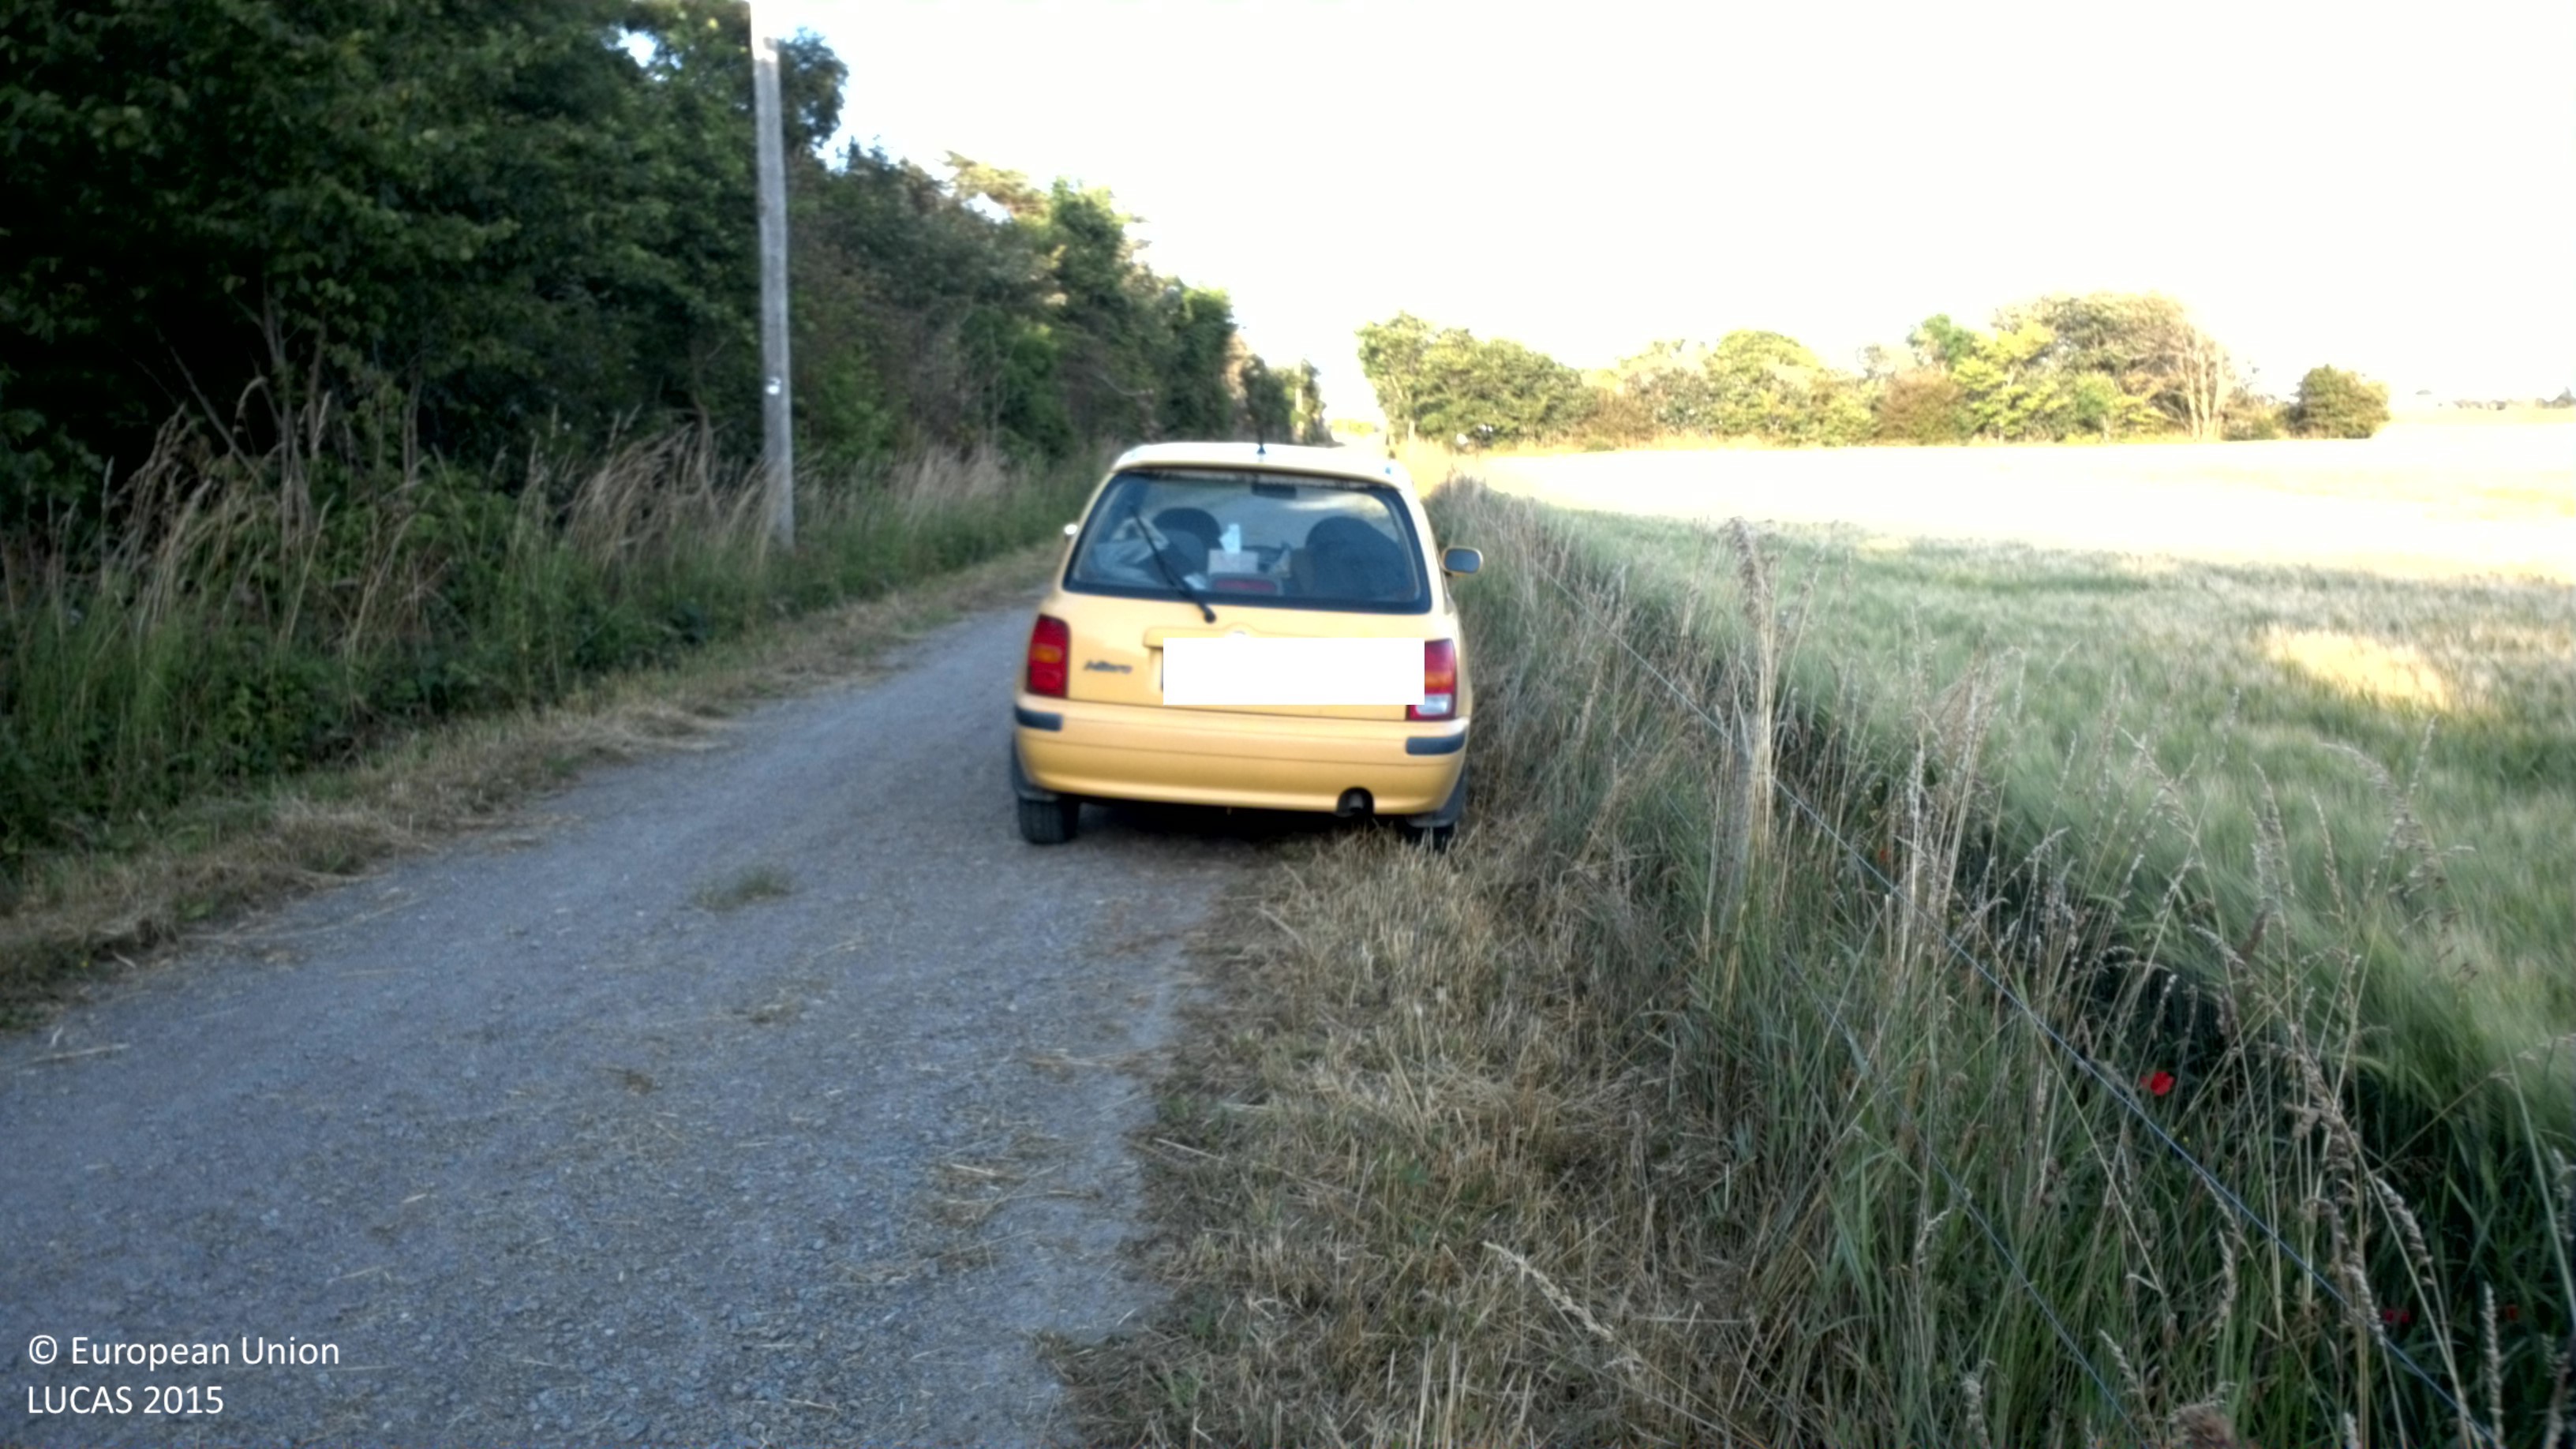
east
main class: Cropland
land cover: Barley
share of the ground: > 75 %
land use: Agriculture (excluding fallow land and kitchen gardens)
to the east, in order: Barley; Electric lines; Barley; Artificial constructions in urban areas
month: July
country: SE
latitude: 56.2620
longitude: 16.4113
